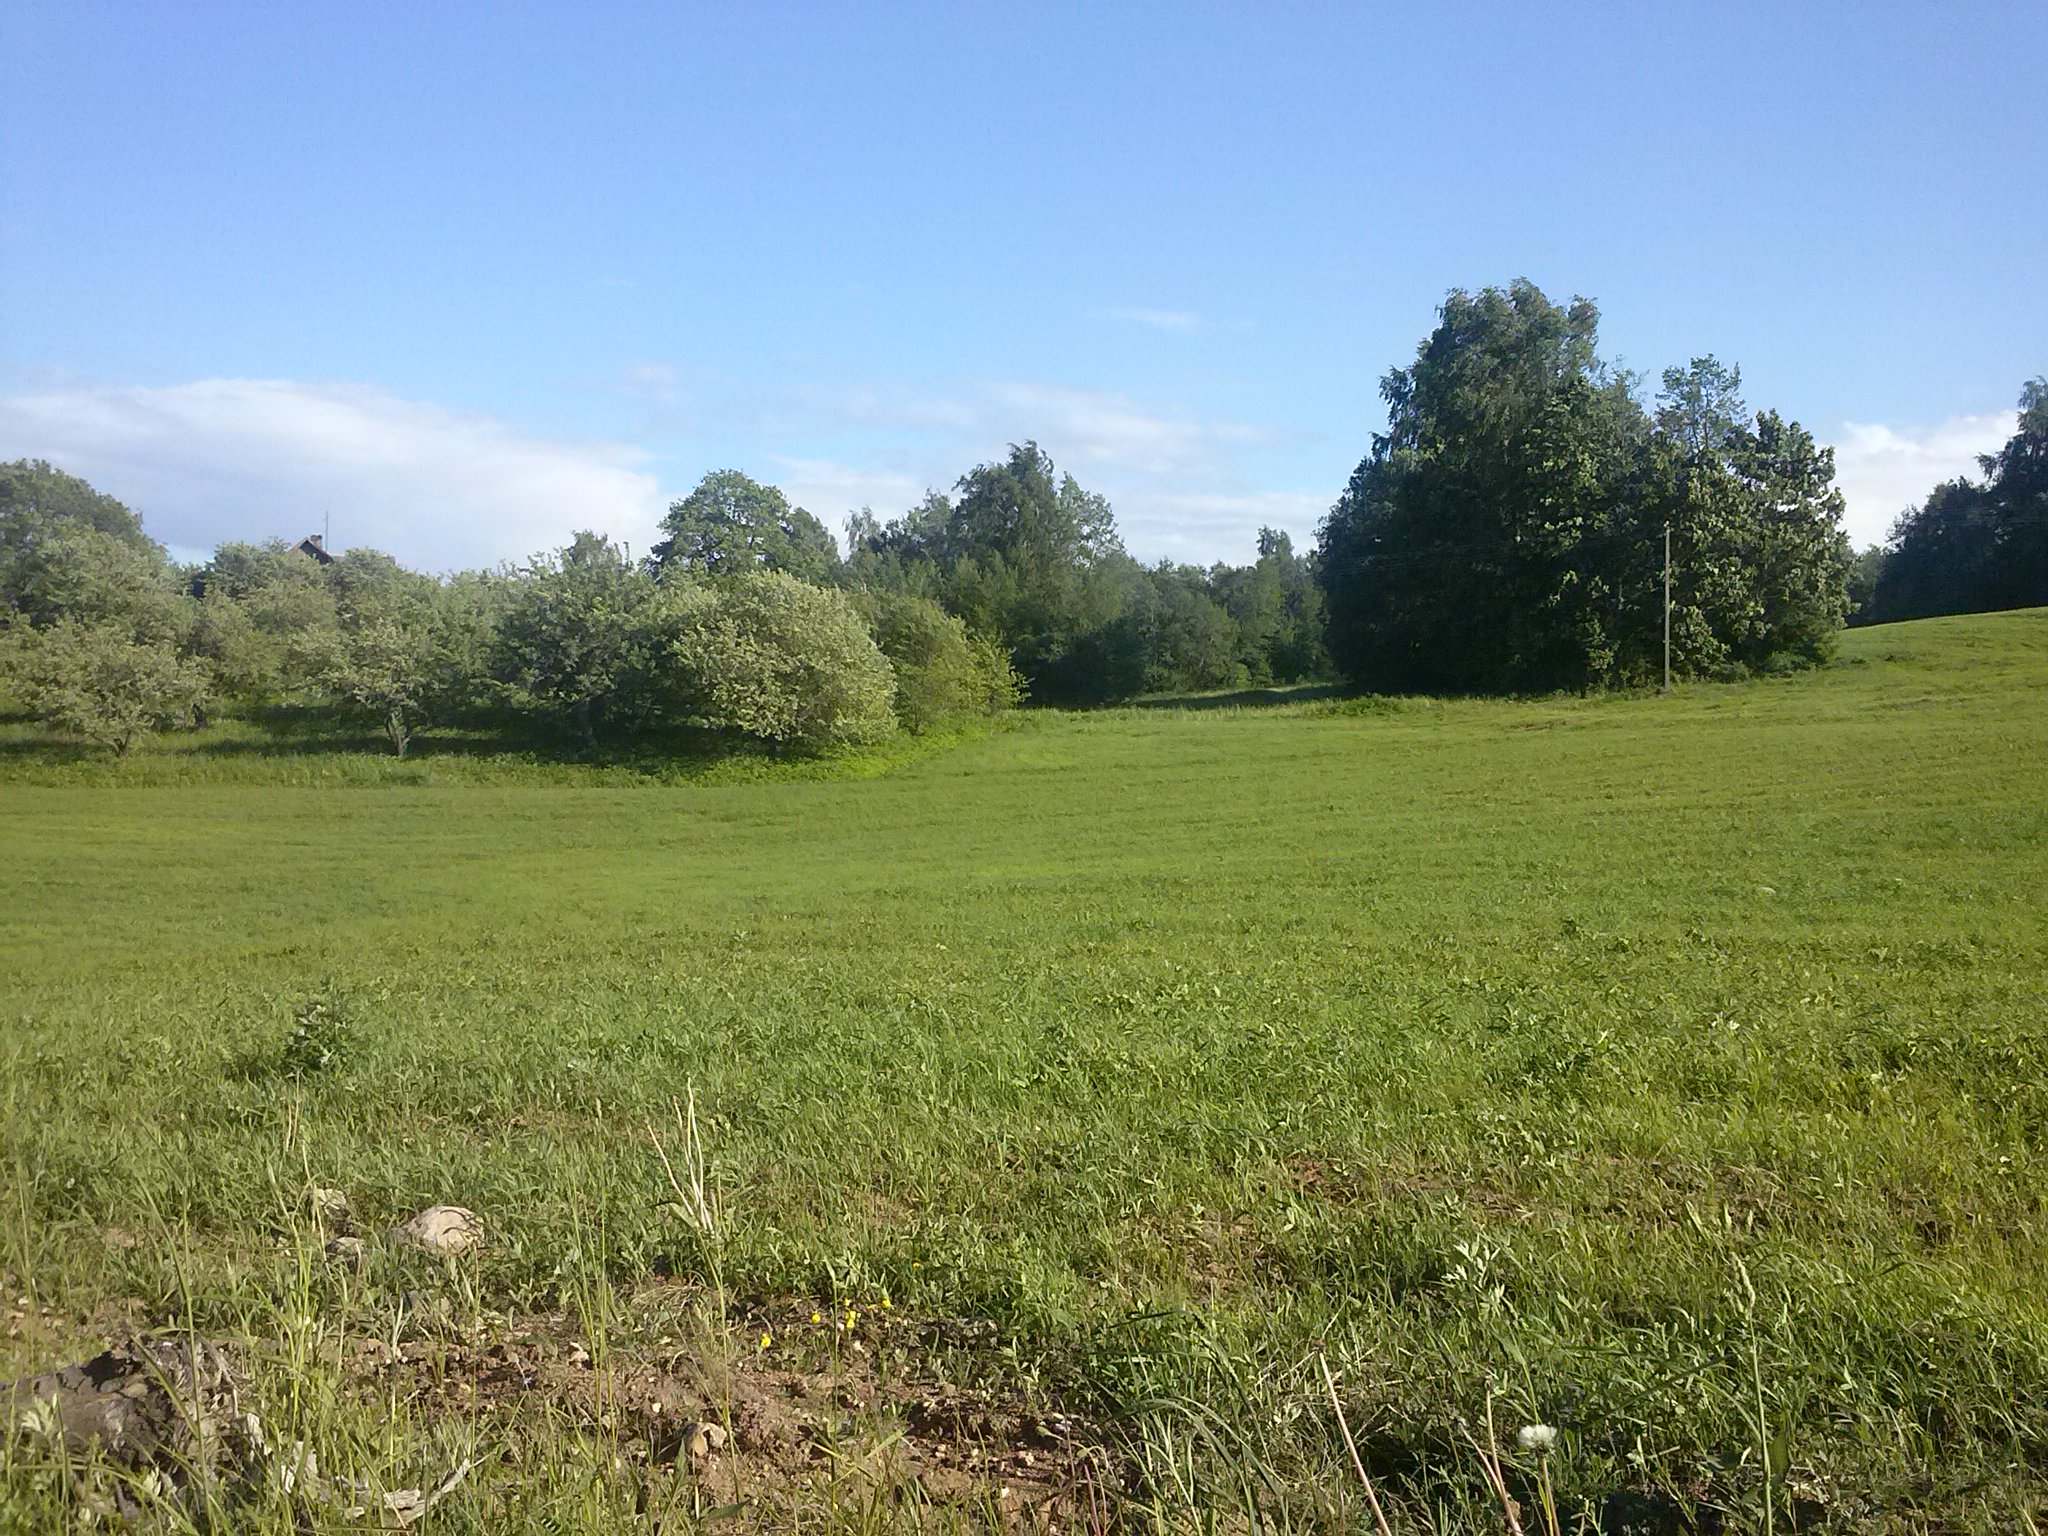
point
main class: Cropland
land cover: Apple fruit
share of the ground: > 75 %
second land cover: Grassland without tree/shrub cover
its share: > 75 %
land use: Kitchen garden
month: June
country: LV
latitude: 56.3486
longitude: 27.6775
